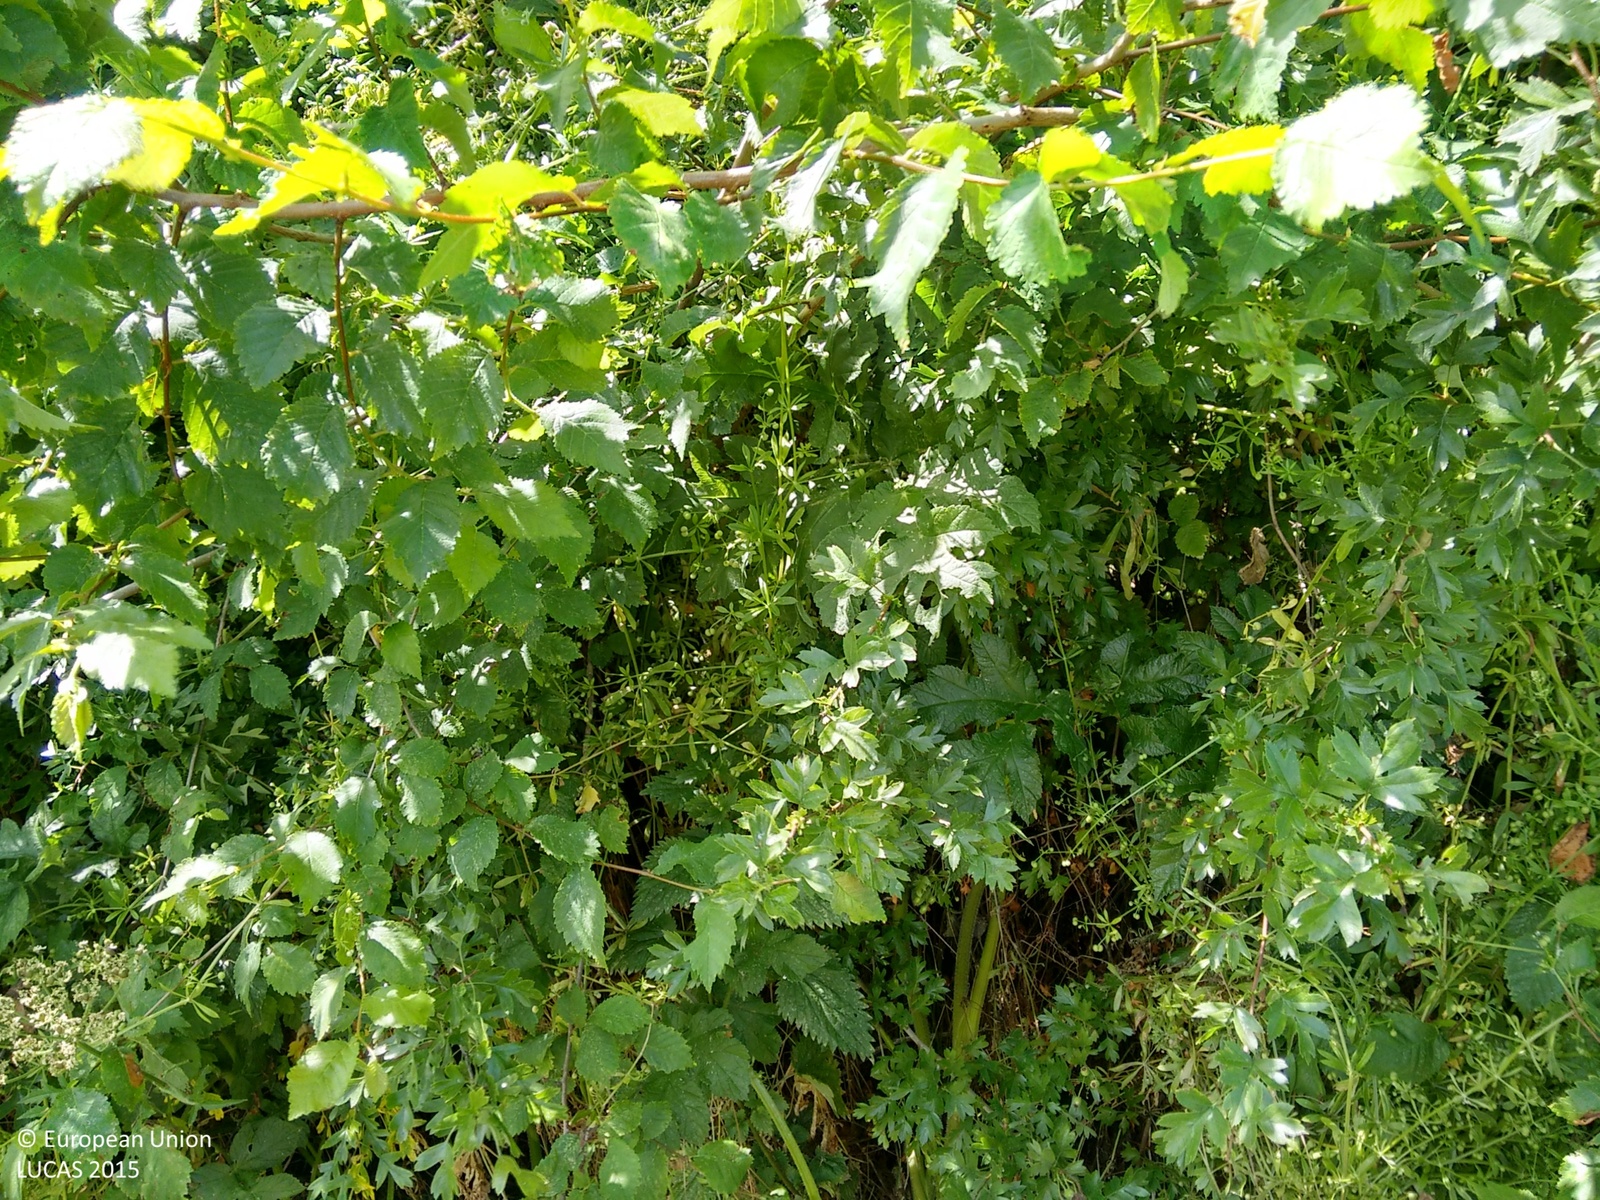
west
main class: Cropland
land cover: Rape and turnip rape
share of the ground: > 75 %
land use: Agriculture (excluding fallow land and kitchen gardens)
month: July
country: GB
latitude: 52.8991
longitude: -1.0001
